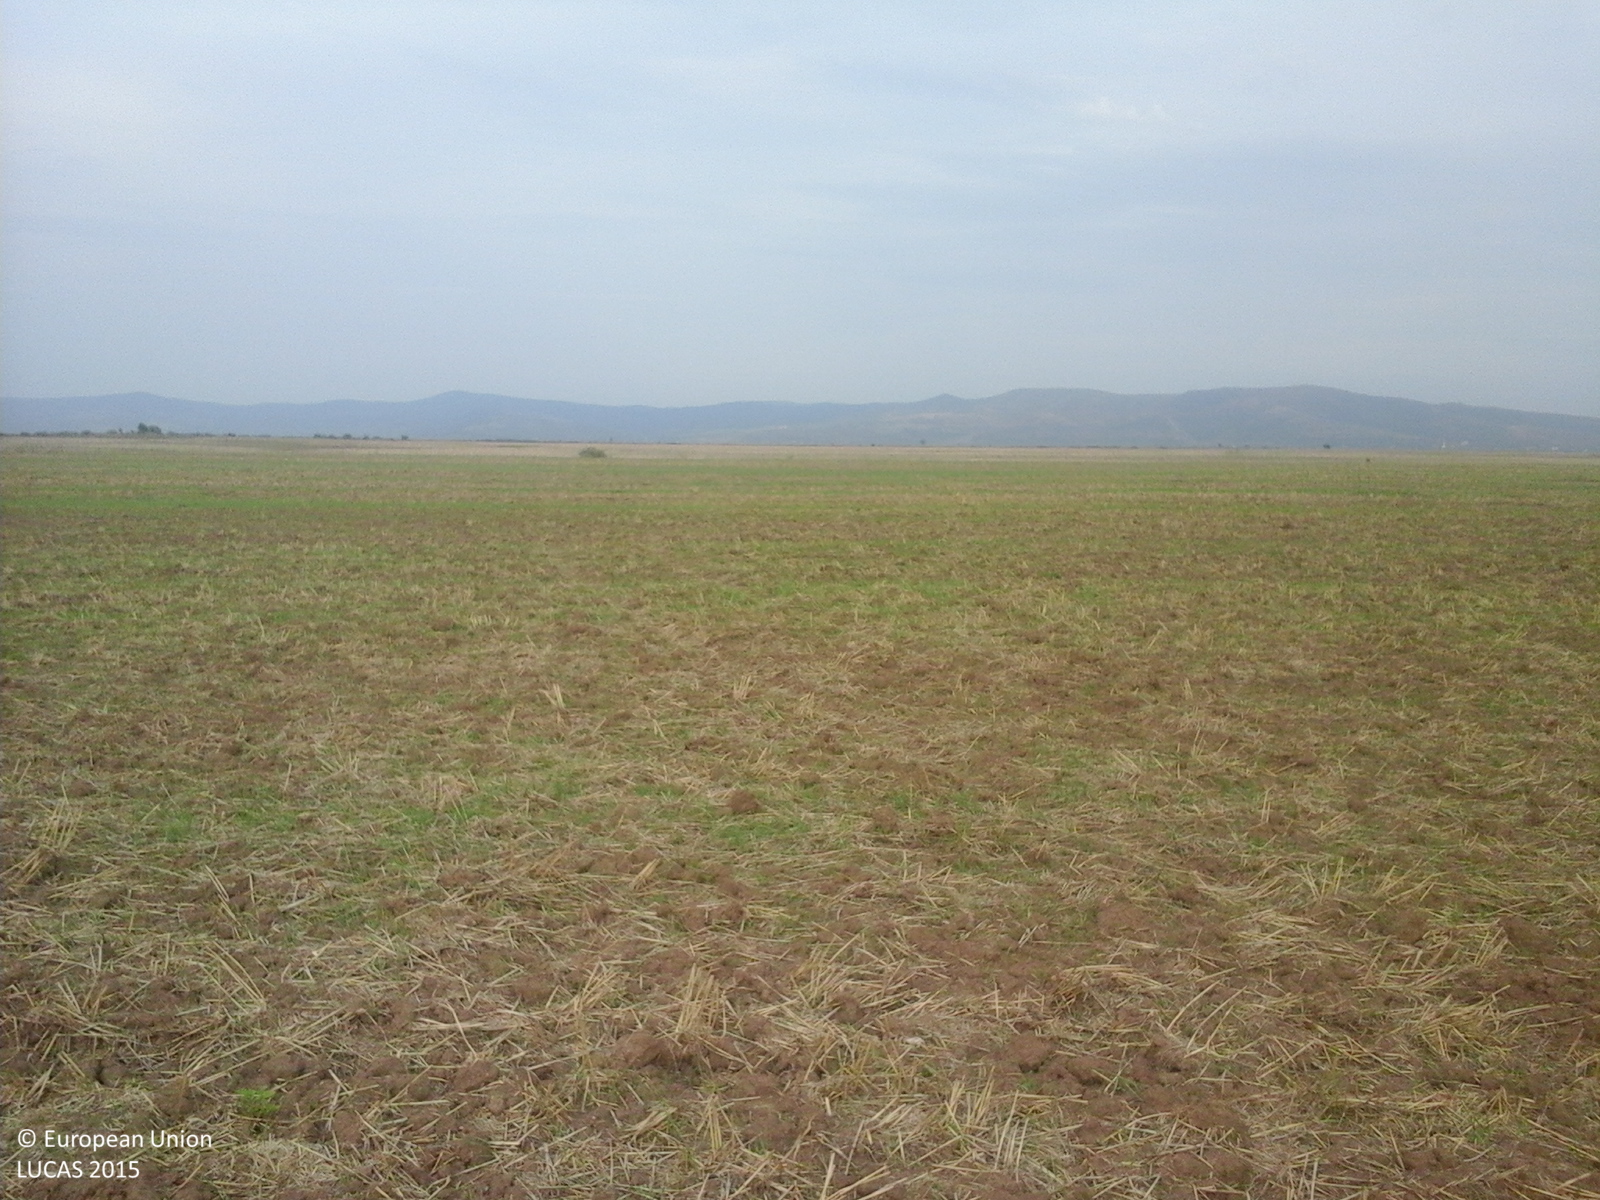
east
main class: Cropland
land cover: Durum wheat
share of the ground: < 10 %
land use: Agriculture (excluding fallow land and kitchen gardens)
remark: Harvested field
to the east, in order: Durum wheat; Grass margins; Ditches and canals; Shruby margins; Rape and turnip rape
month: August
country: RO
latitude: 46.1832
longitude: 21.5015
